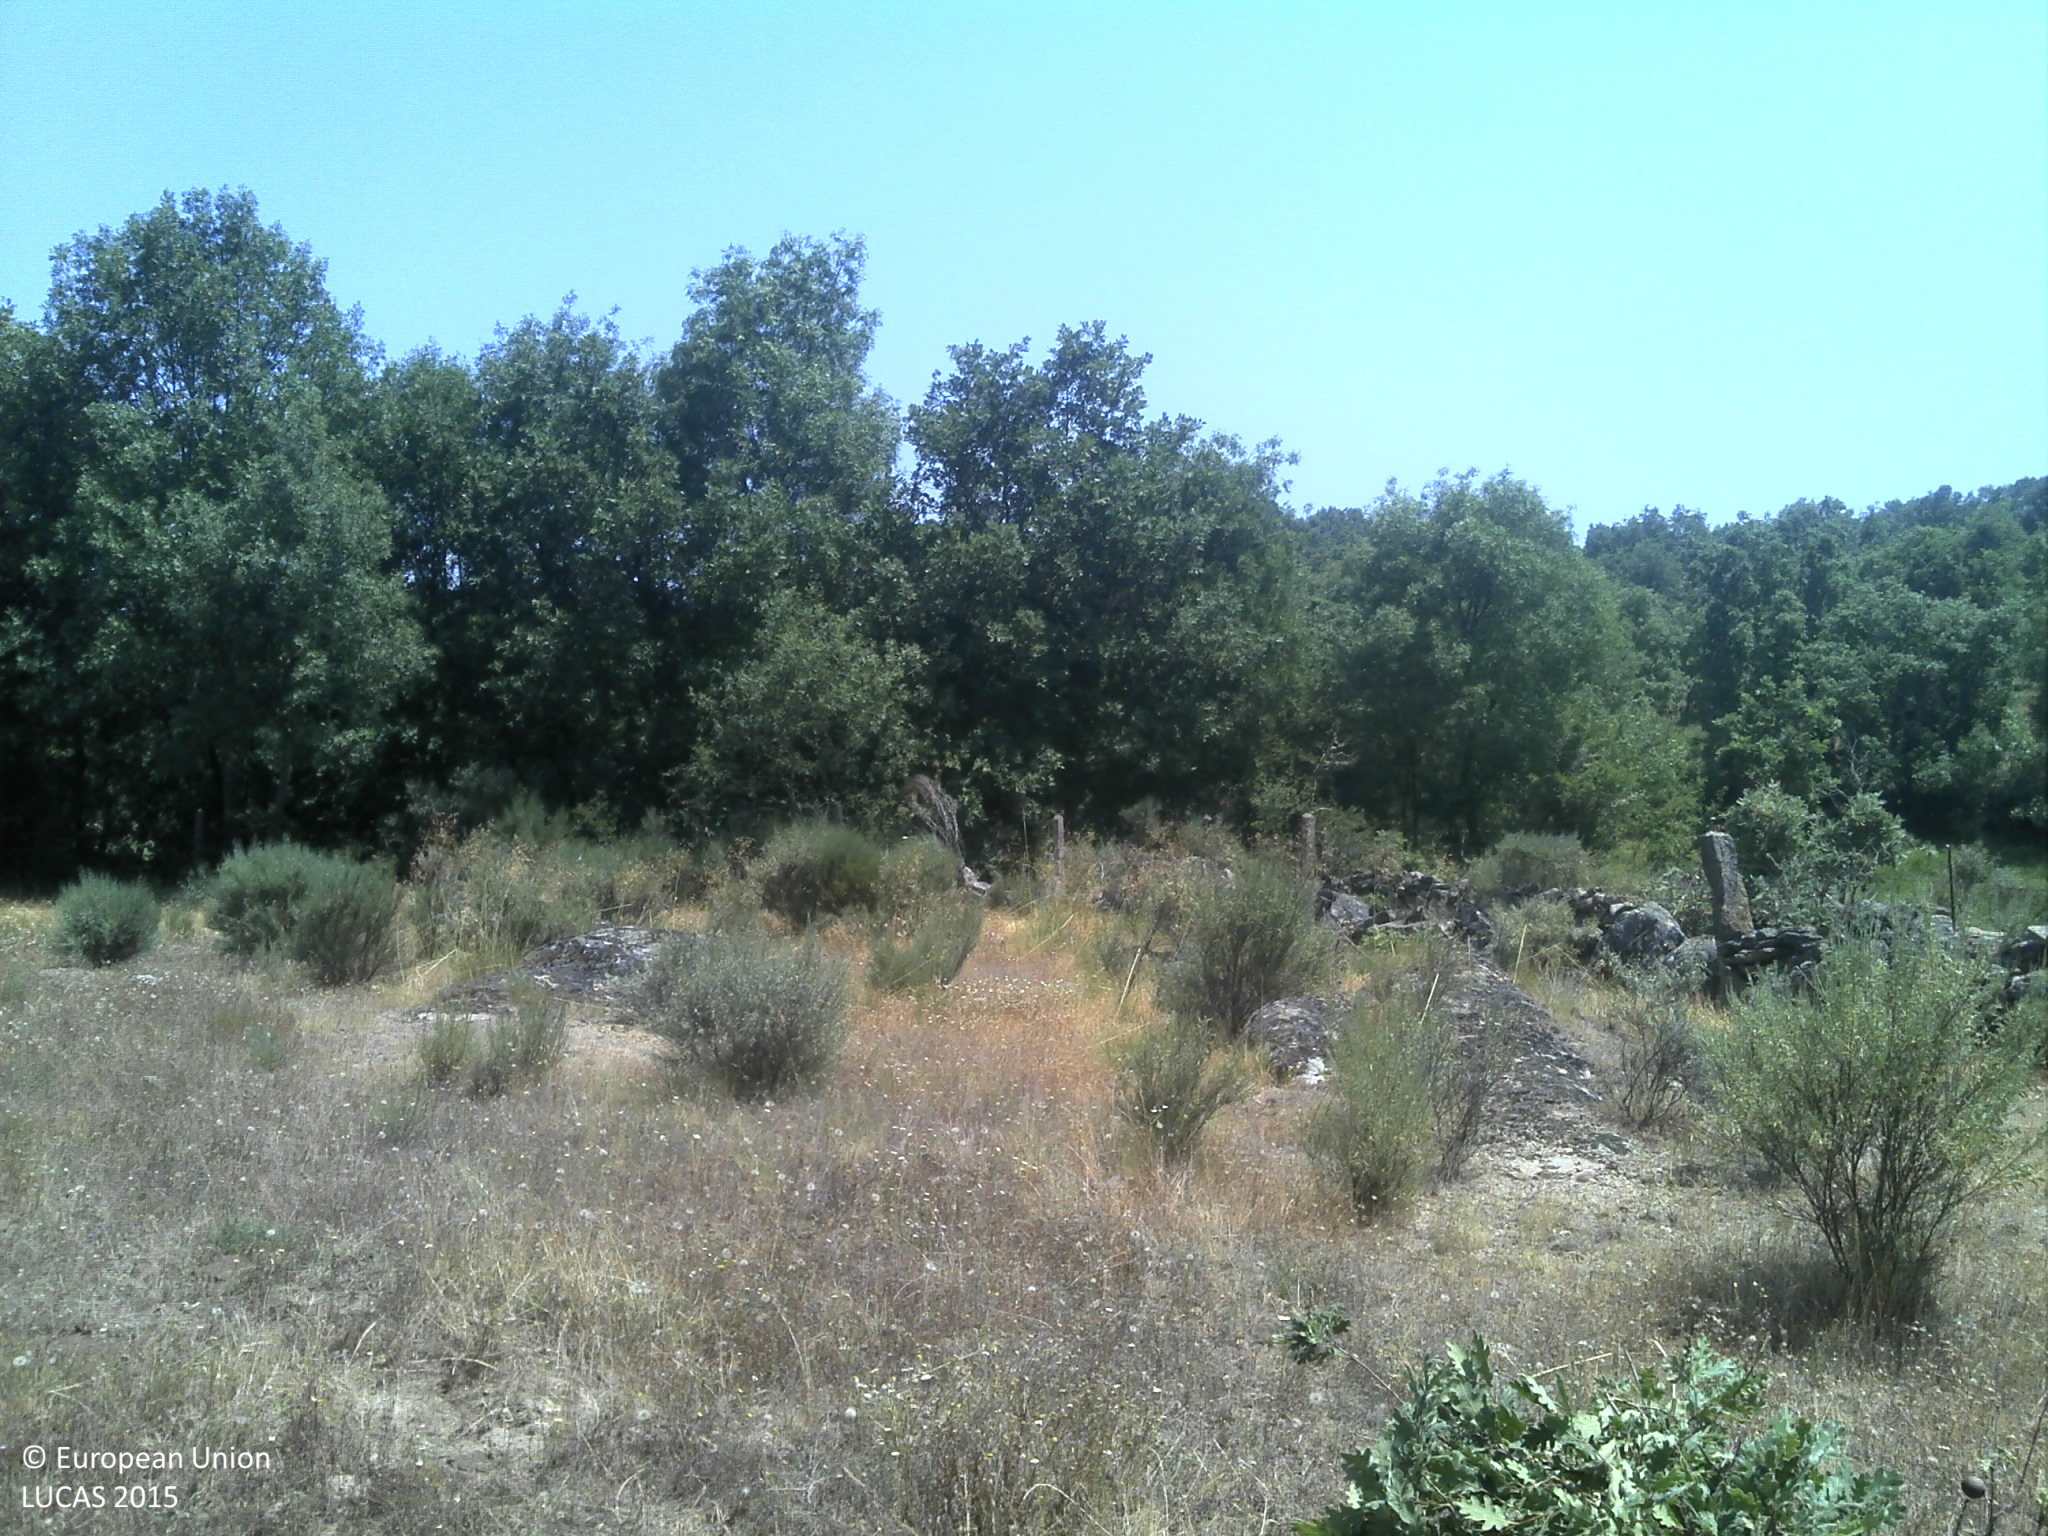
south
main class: Grassland
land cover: Grassland with sparse tree/shrub cover
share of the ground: 50 - 75 %
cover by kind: herbaceous plants 75 %, unconsolidated bare surface 20 %, broadleaved forest trees 5 %
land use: Agriculture (excluding fallow land and kitchen gardens)
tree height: > 5 m
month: June
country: PT
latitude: 40.3726
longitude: -6.8046
